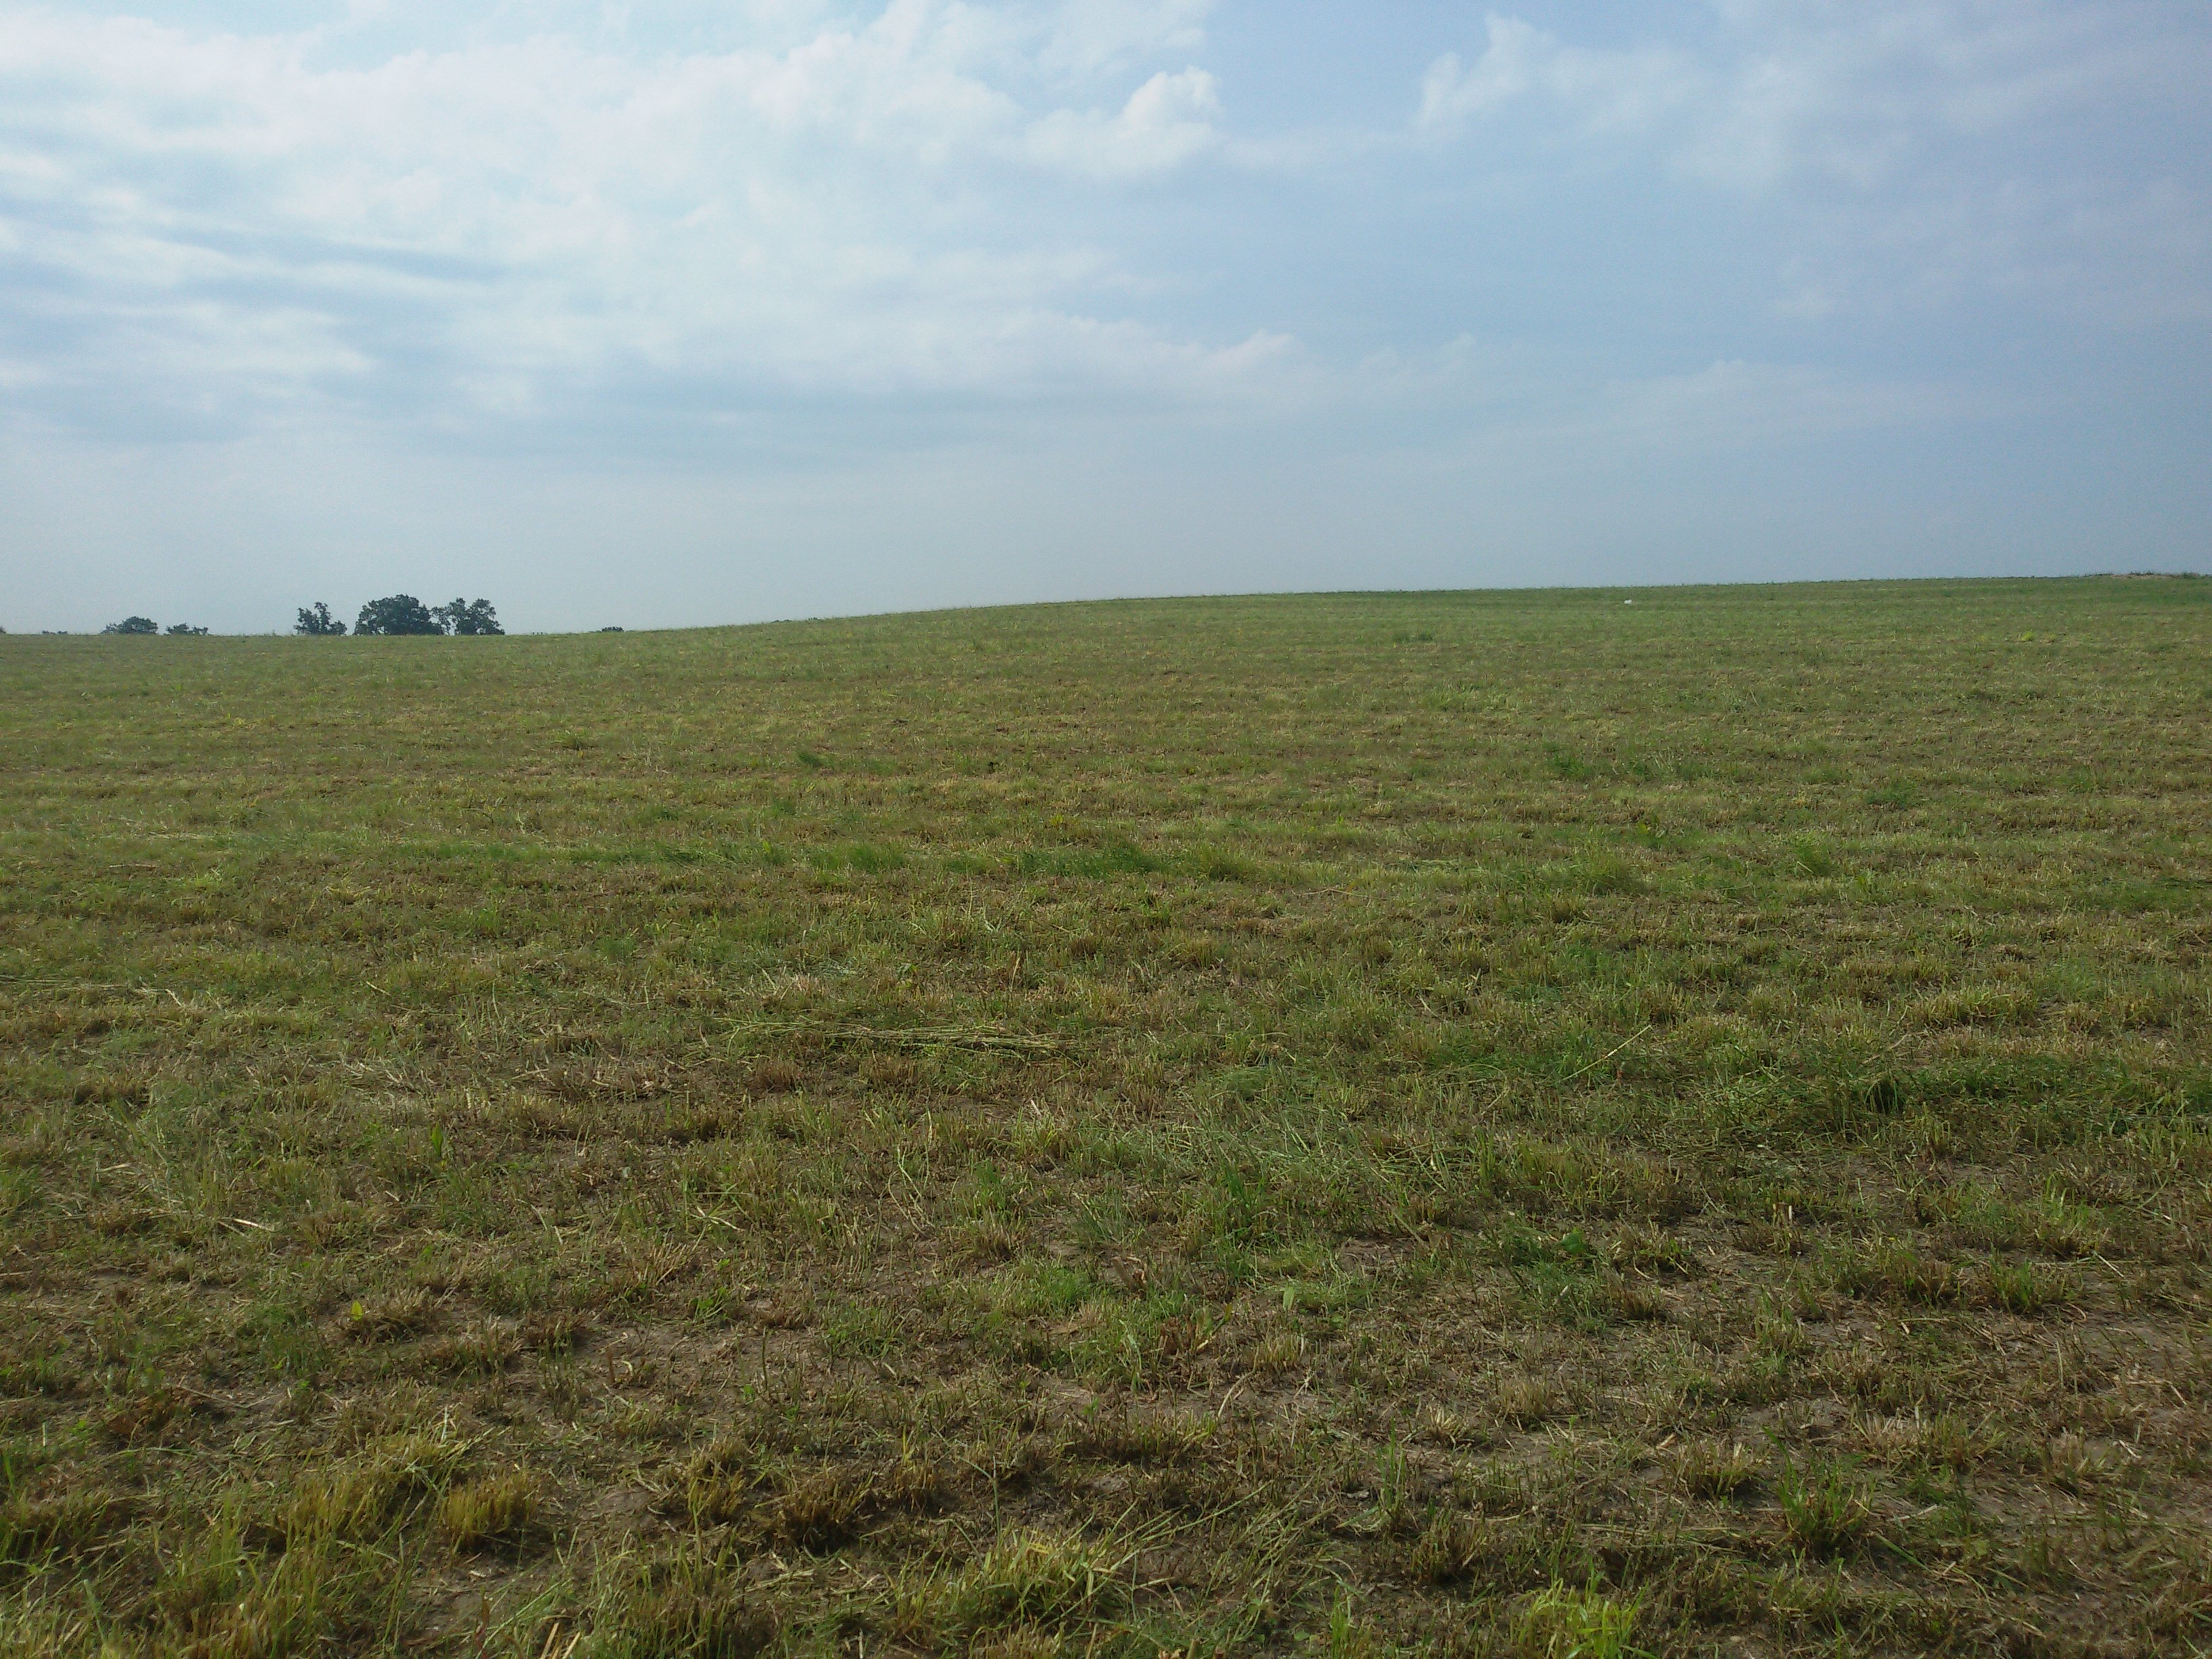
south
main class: Cropland
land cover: Temporary grasslands
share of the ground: > 75 %
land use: Agriculture (excluding fallow land and kitchen gardens)
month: May
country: PL
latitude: 50.4989
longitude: 17.1868
